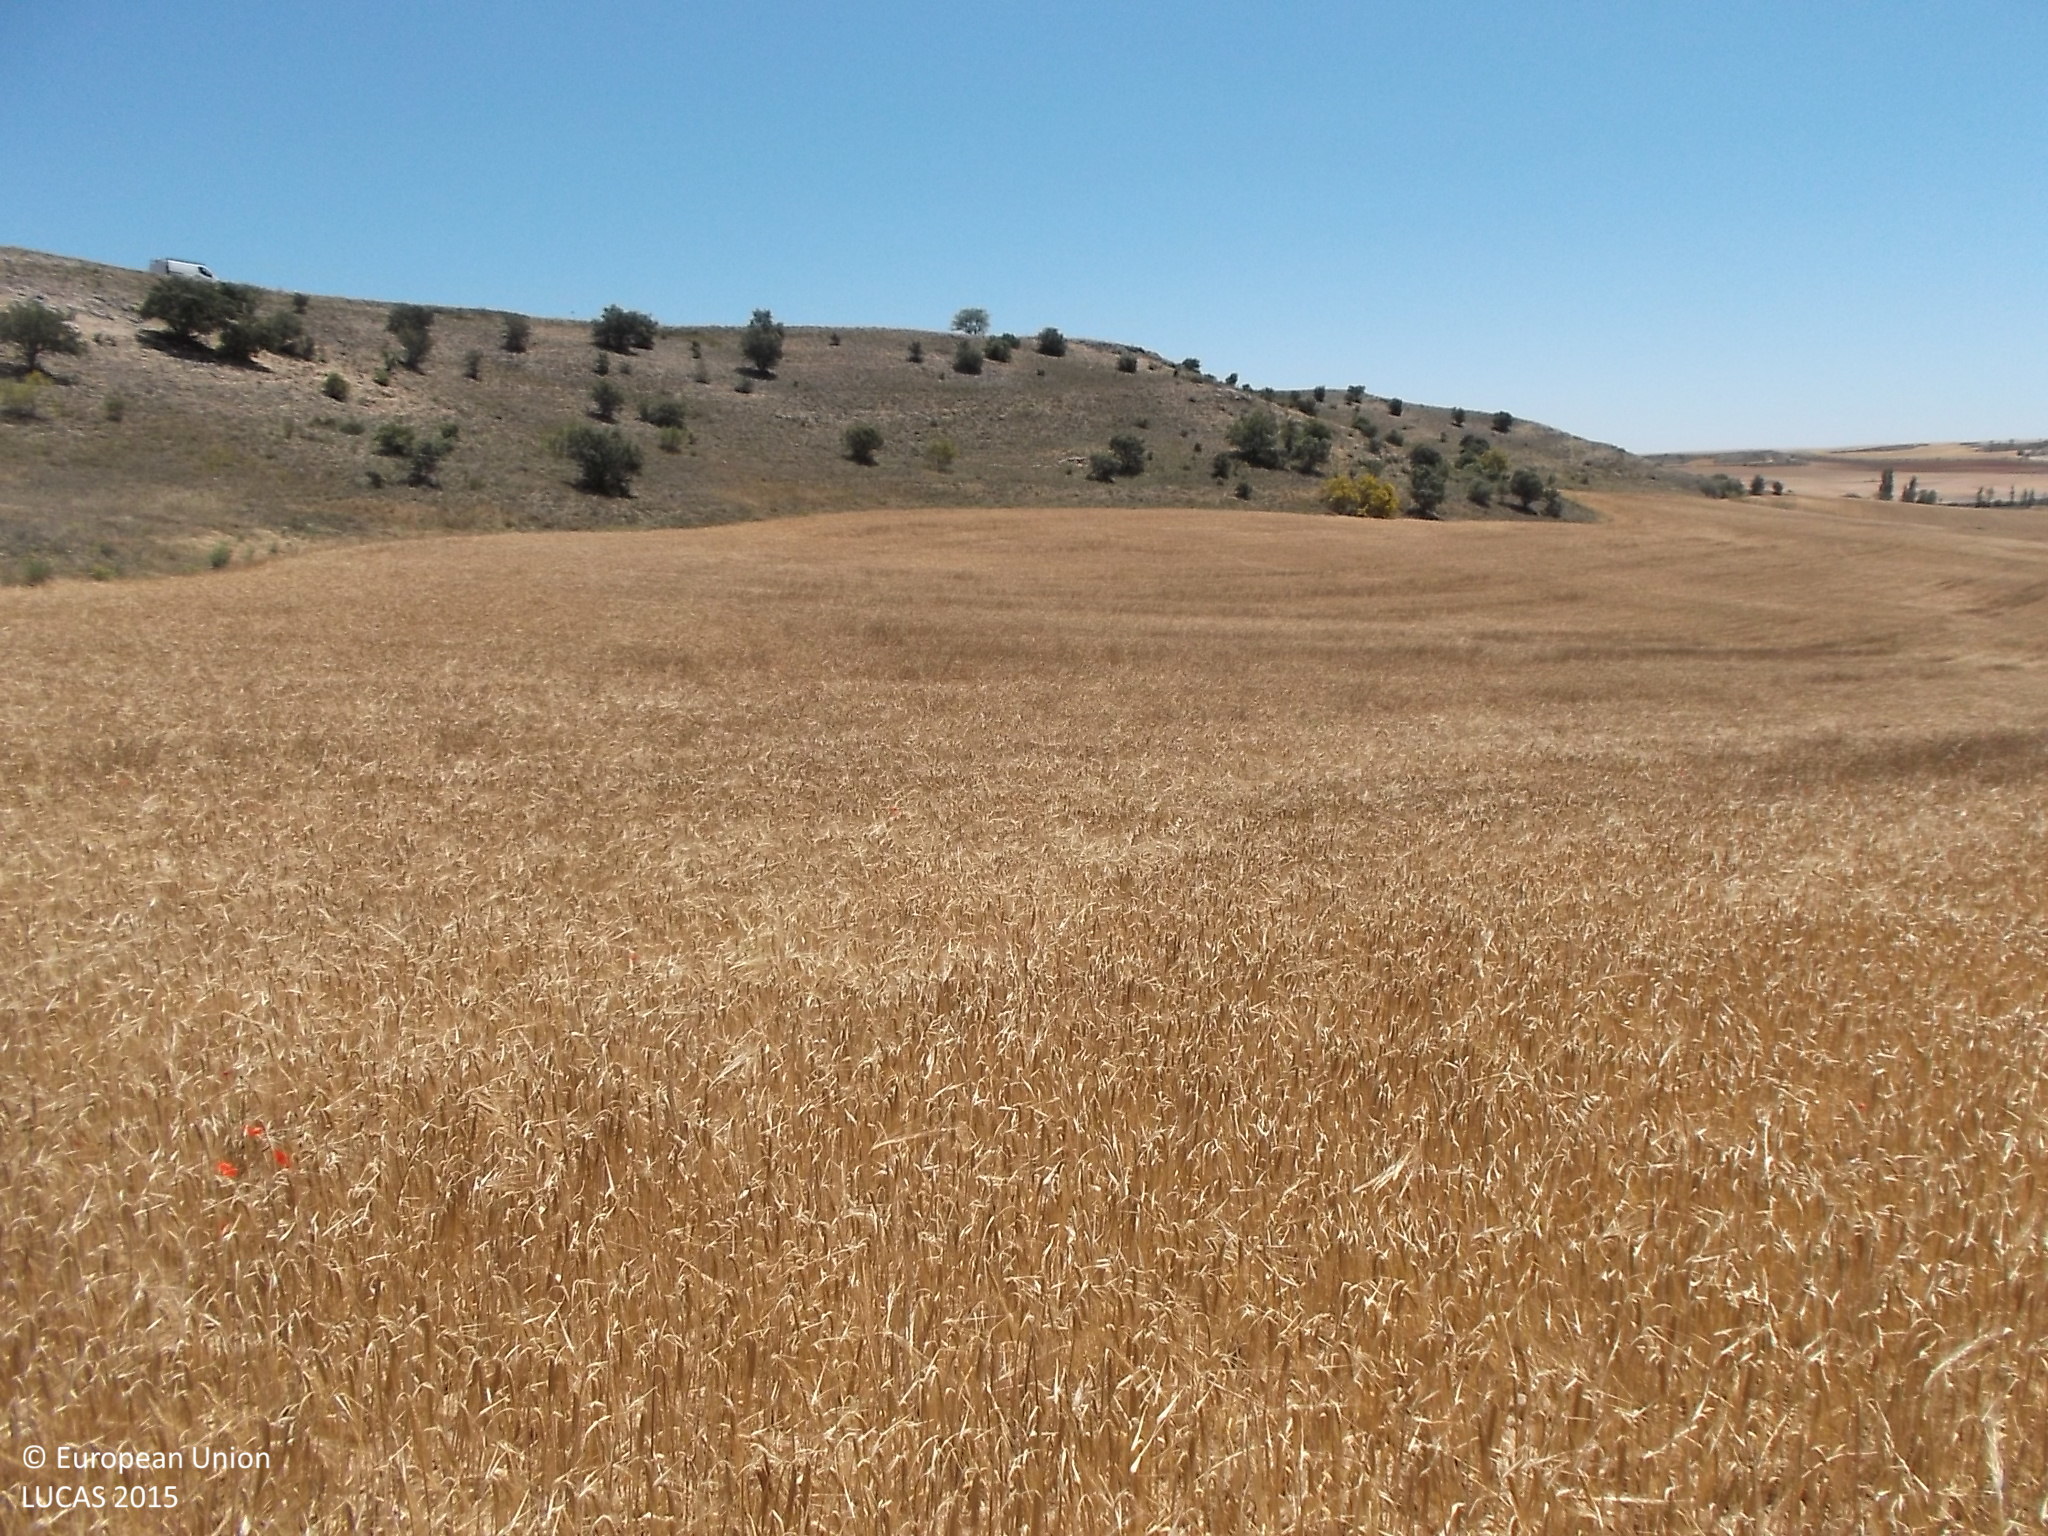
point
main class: Cropland
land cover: Barley
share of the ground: > 75 %
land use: Agriculture (excluding fallow land and kitchen gardens)
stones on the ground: < 10 %
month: June
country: ES
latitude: 41.3632
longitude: -5.3666
